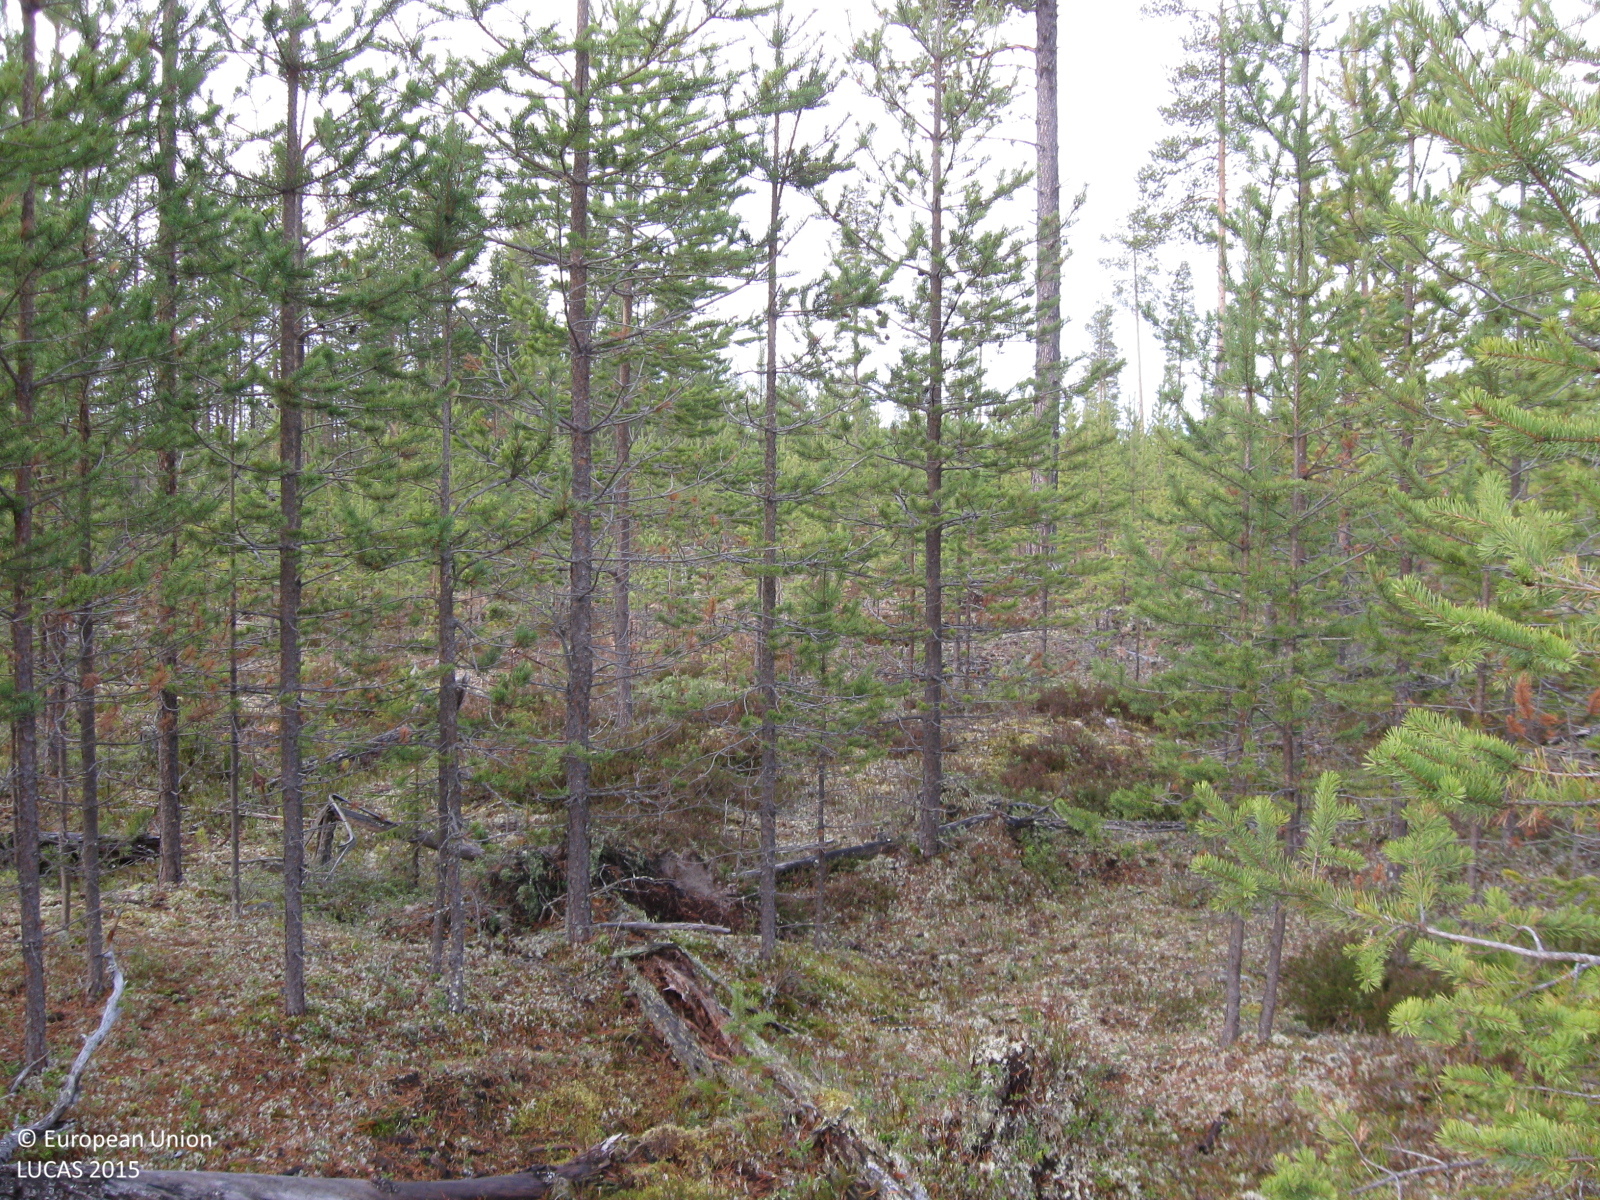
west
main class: Woodland
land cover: Pine dominated coniferous woodland
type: boreal forest
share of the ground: 50 - 75 %
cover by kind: coniferous forest trees 65 %, shrubs 15 %, lichens and mosses 10 %, herbaceous plants 5 %
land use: Forestry
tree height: < 5 m
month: November
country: SE
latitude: 66.0532
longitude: 20.5817
